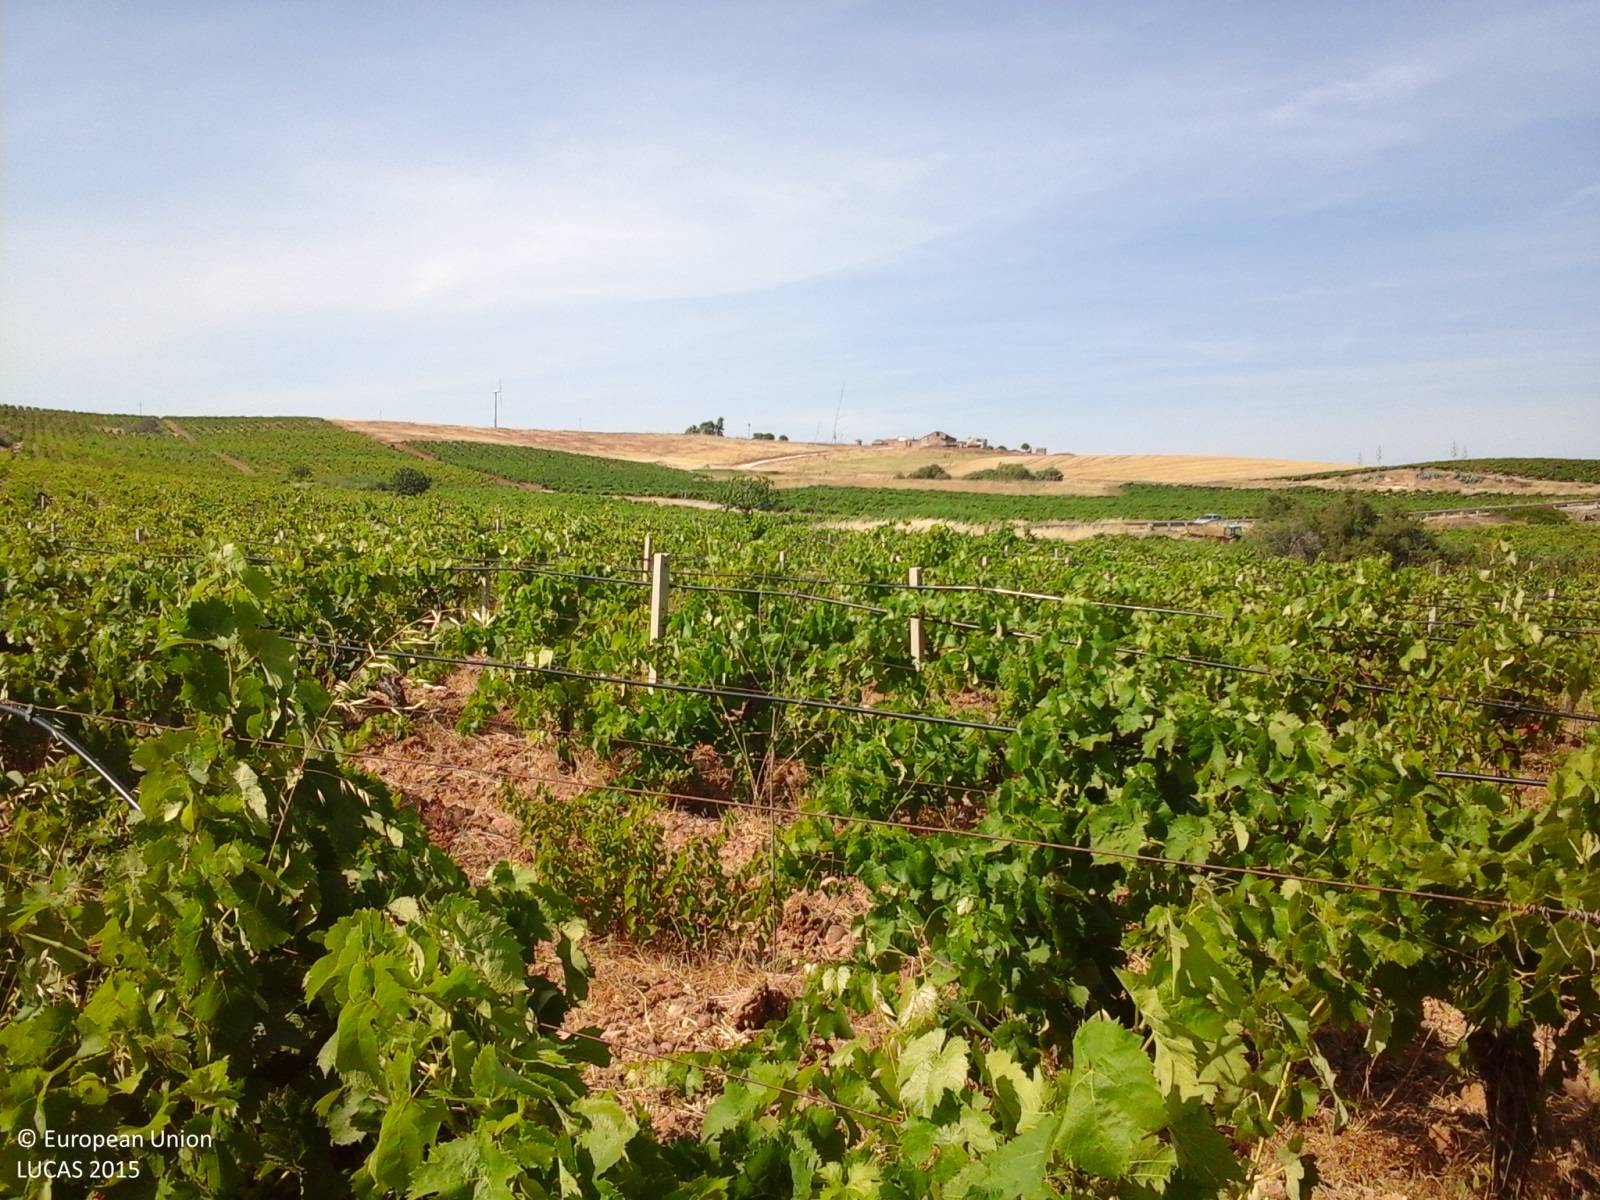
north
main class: Cropland
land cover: Vineyards
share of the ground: 50 - 75 %
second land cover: Other bare soil
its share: > 75 %
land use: Agriculture (excluding fallow land and kitchen gardens)
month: June
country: IT
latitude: 37.8190
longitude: 12.6725
